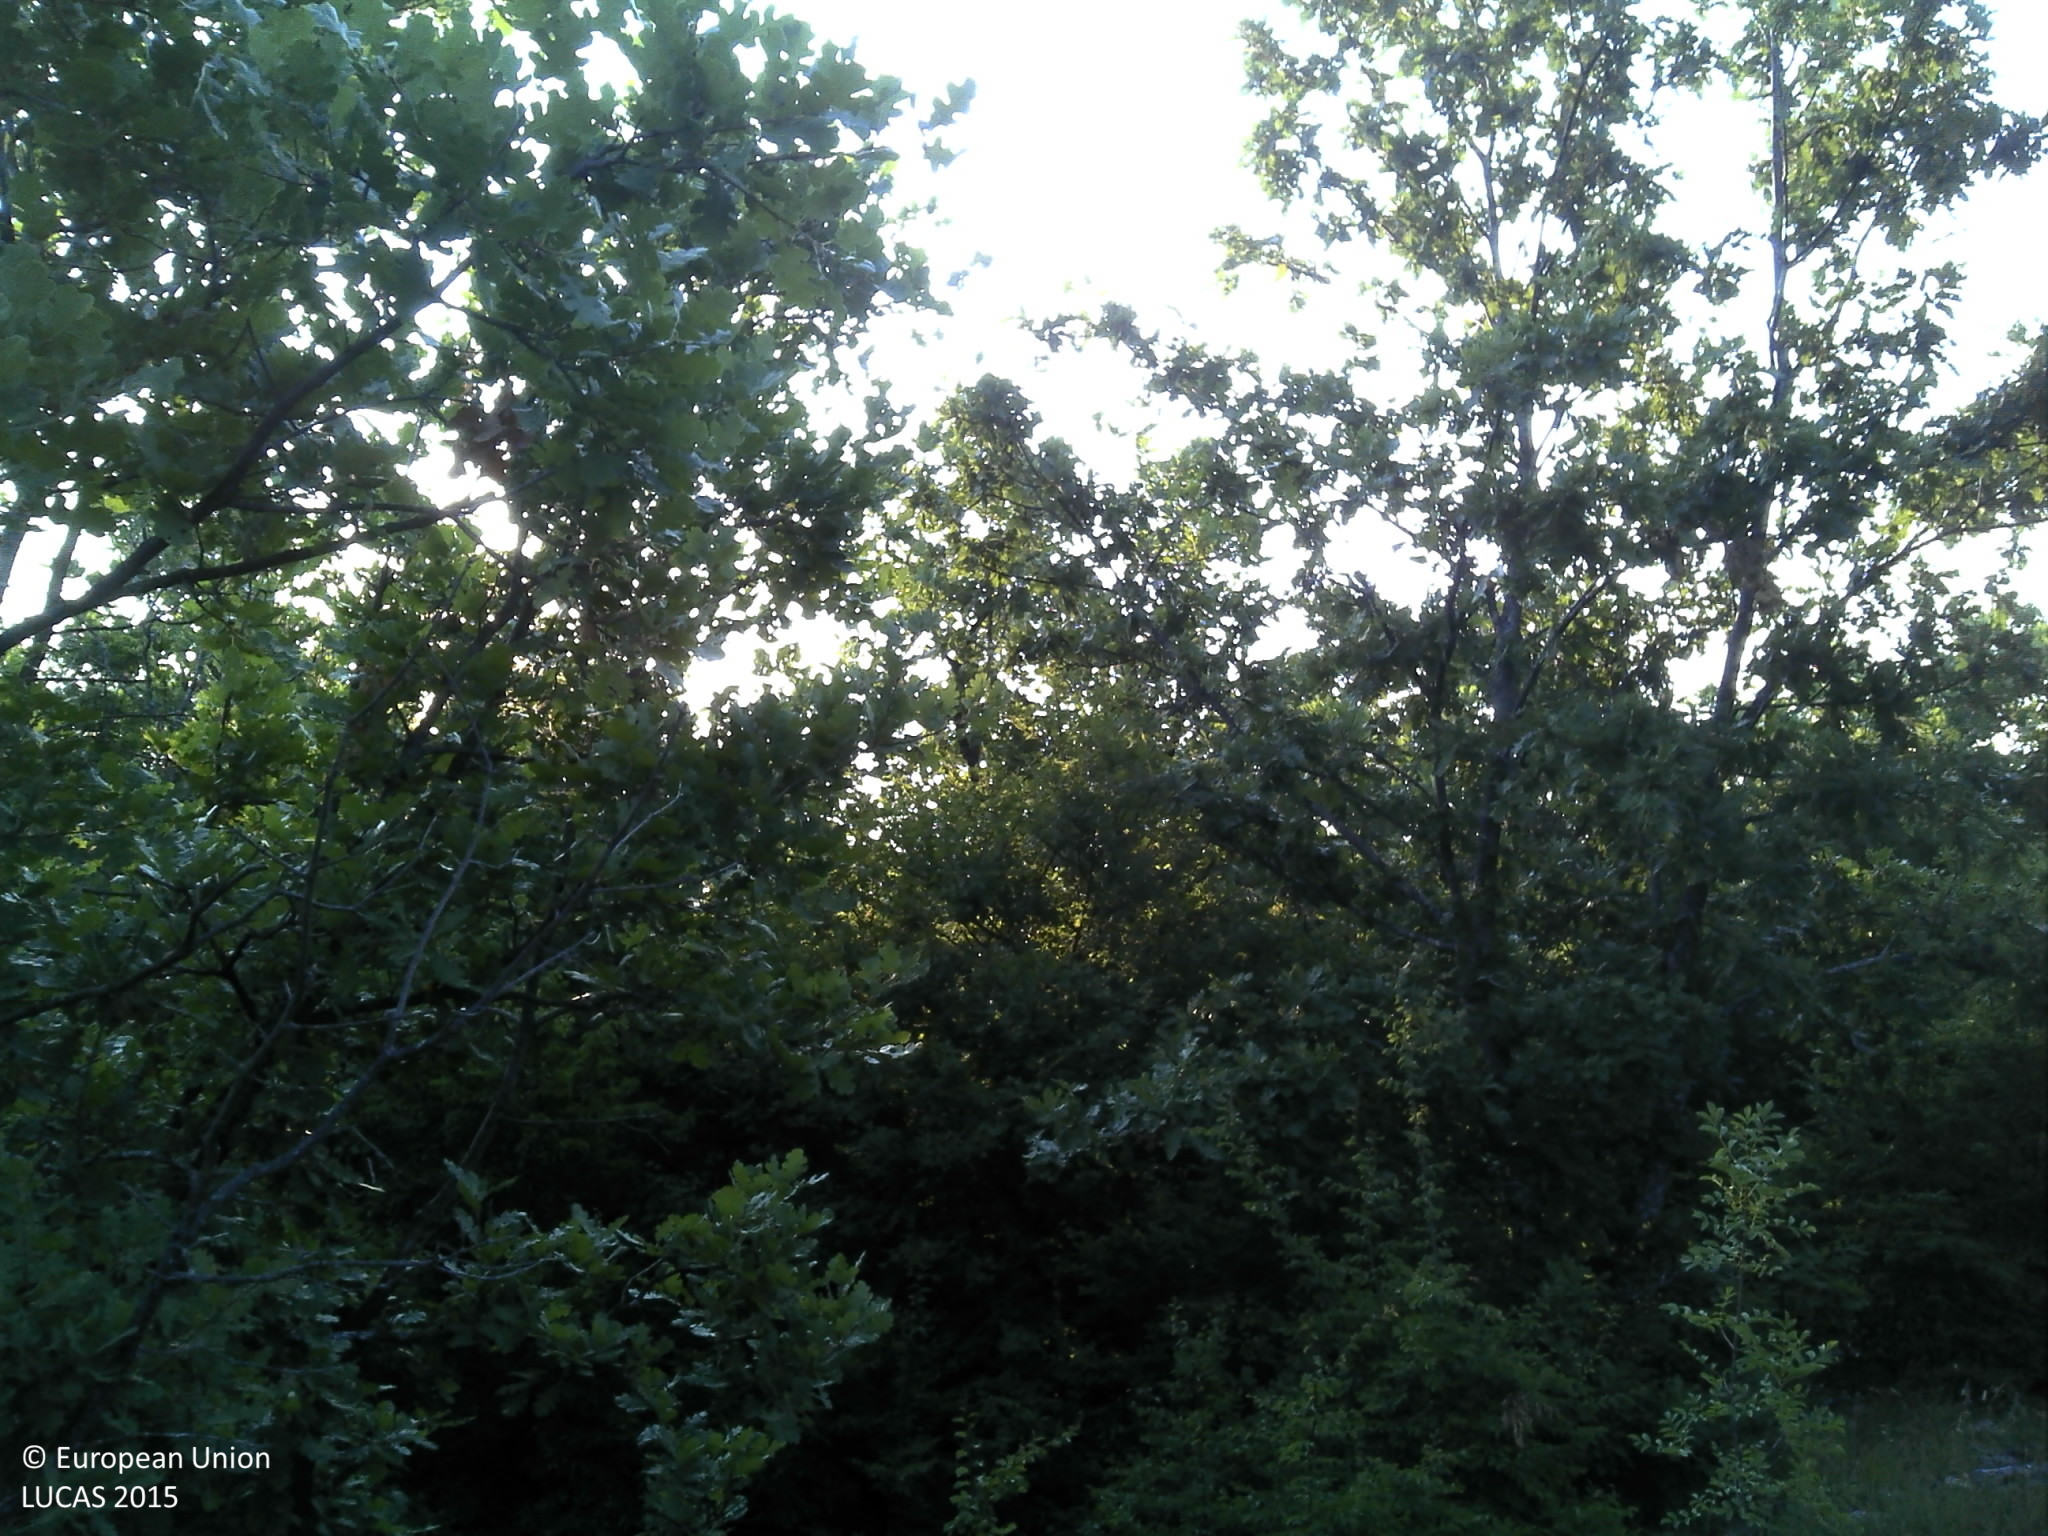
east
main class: Woodland
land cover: Broadleaved woodland
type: thermophilous deciduous forest
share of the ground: 50 - 75 %
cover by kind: broadleaved forest trees 50 %, shrubs 40 %, unconsolidated bare surface 10 %
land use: Semi-natural and natural areas not in use
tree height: > 5 m
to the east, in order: Broadleaved woodland; Shrubland with sparse tree cover; Rock outcrops; Shrubland with sparse tree cover; Broadleaved woodland
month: July
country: HR
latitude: 44.0134
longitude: 16.3167
